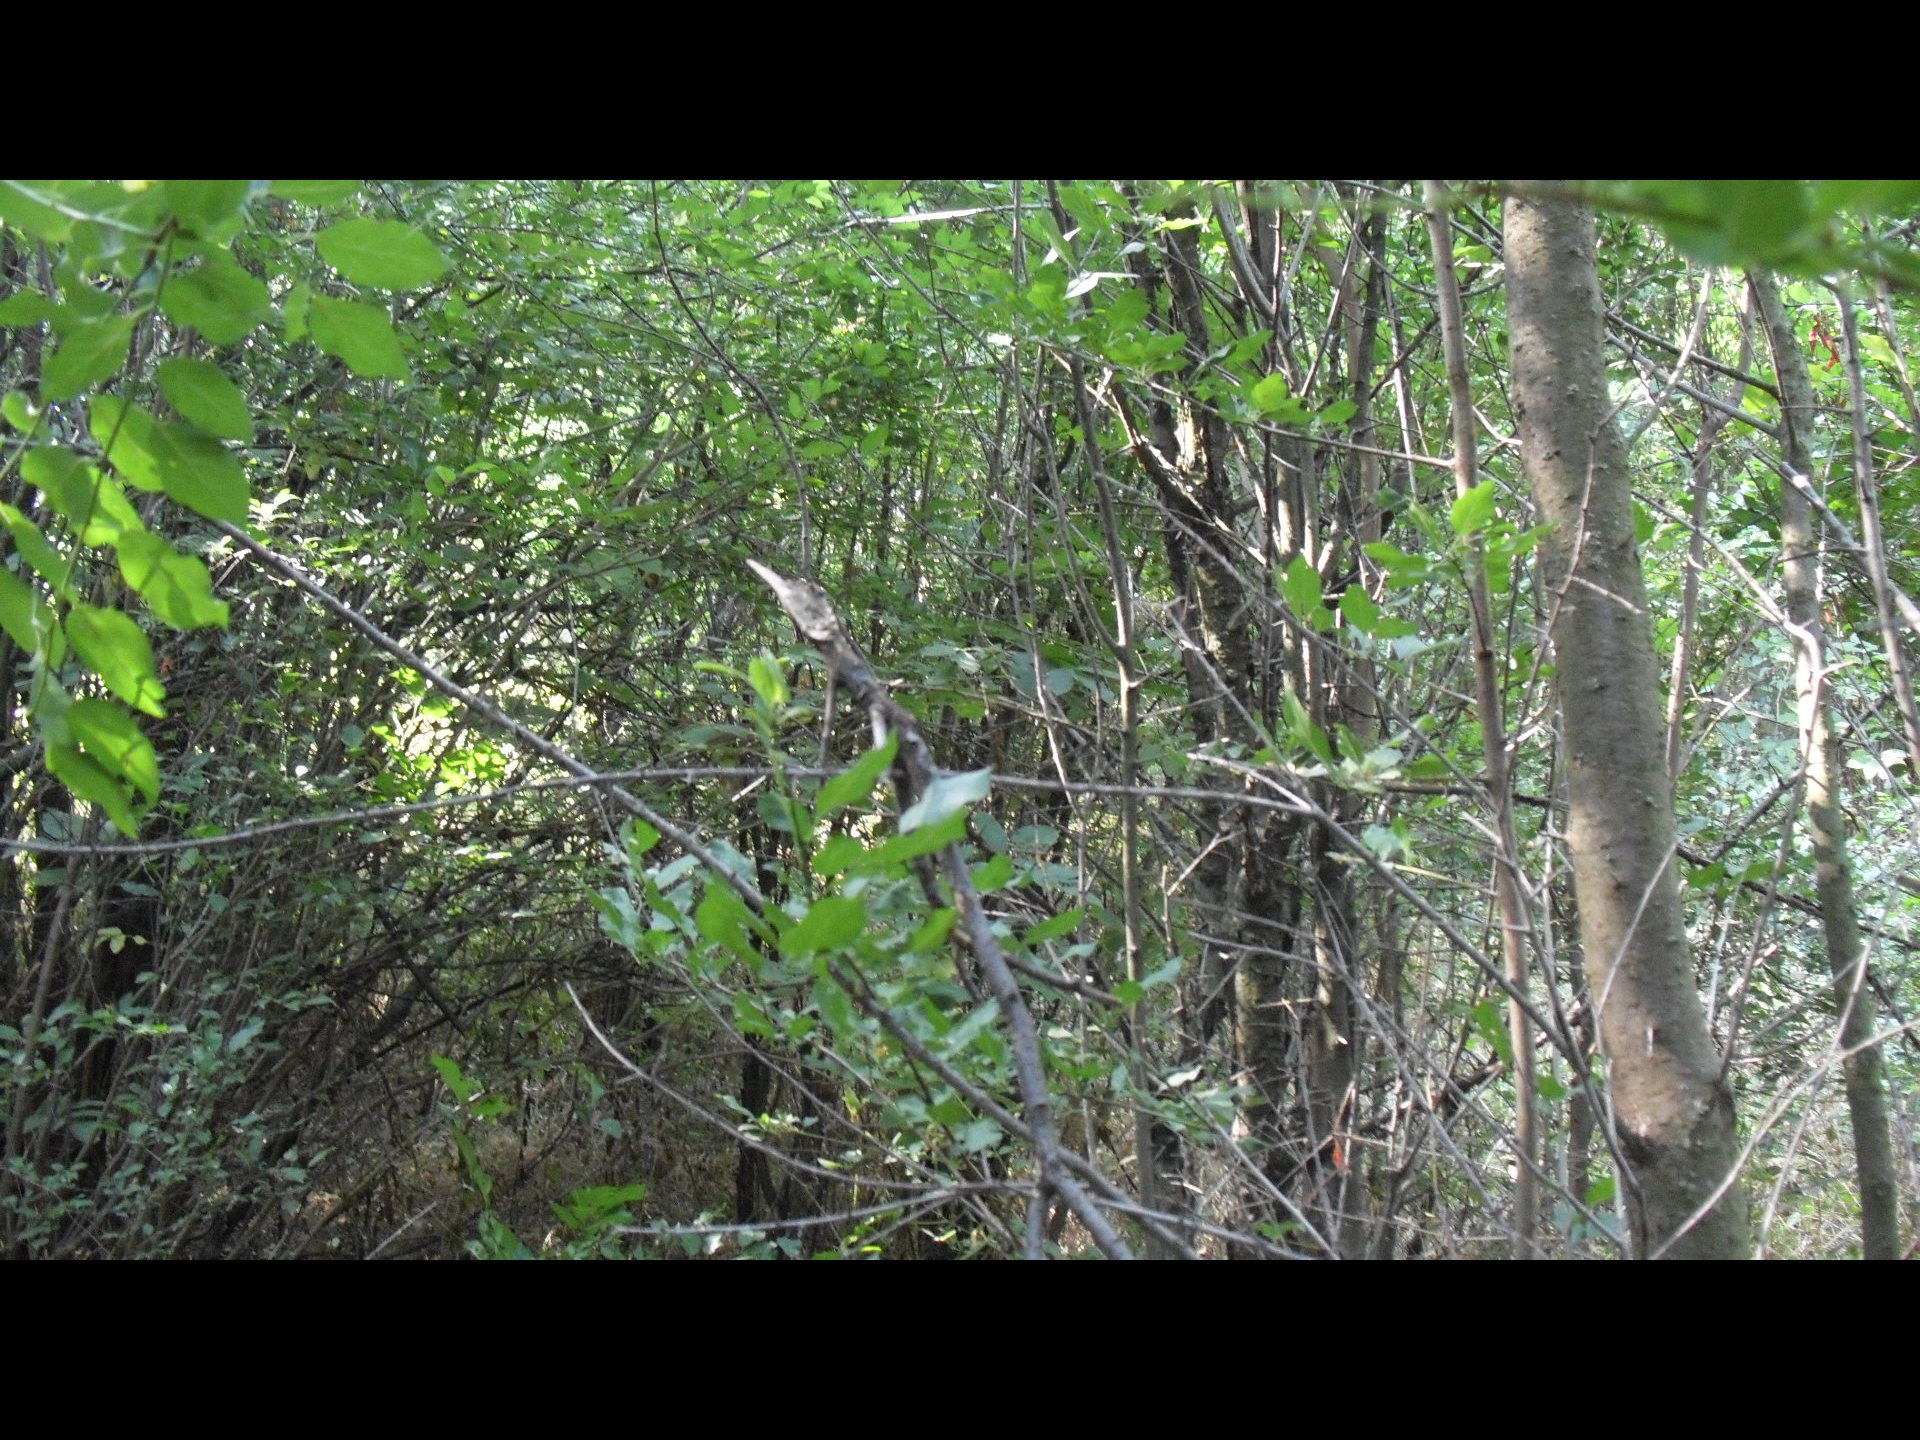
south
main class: Woodland
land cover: Broadleaved woodland
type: beech forest
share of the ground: > 75 %
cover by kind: broadleaved forest trees 95 %, shrubs 5 %
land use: Forestry
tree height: > 5 m
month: August
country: BG
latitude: 43.6659
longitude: 23.6278
